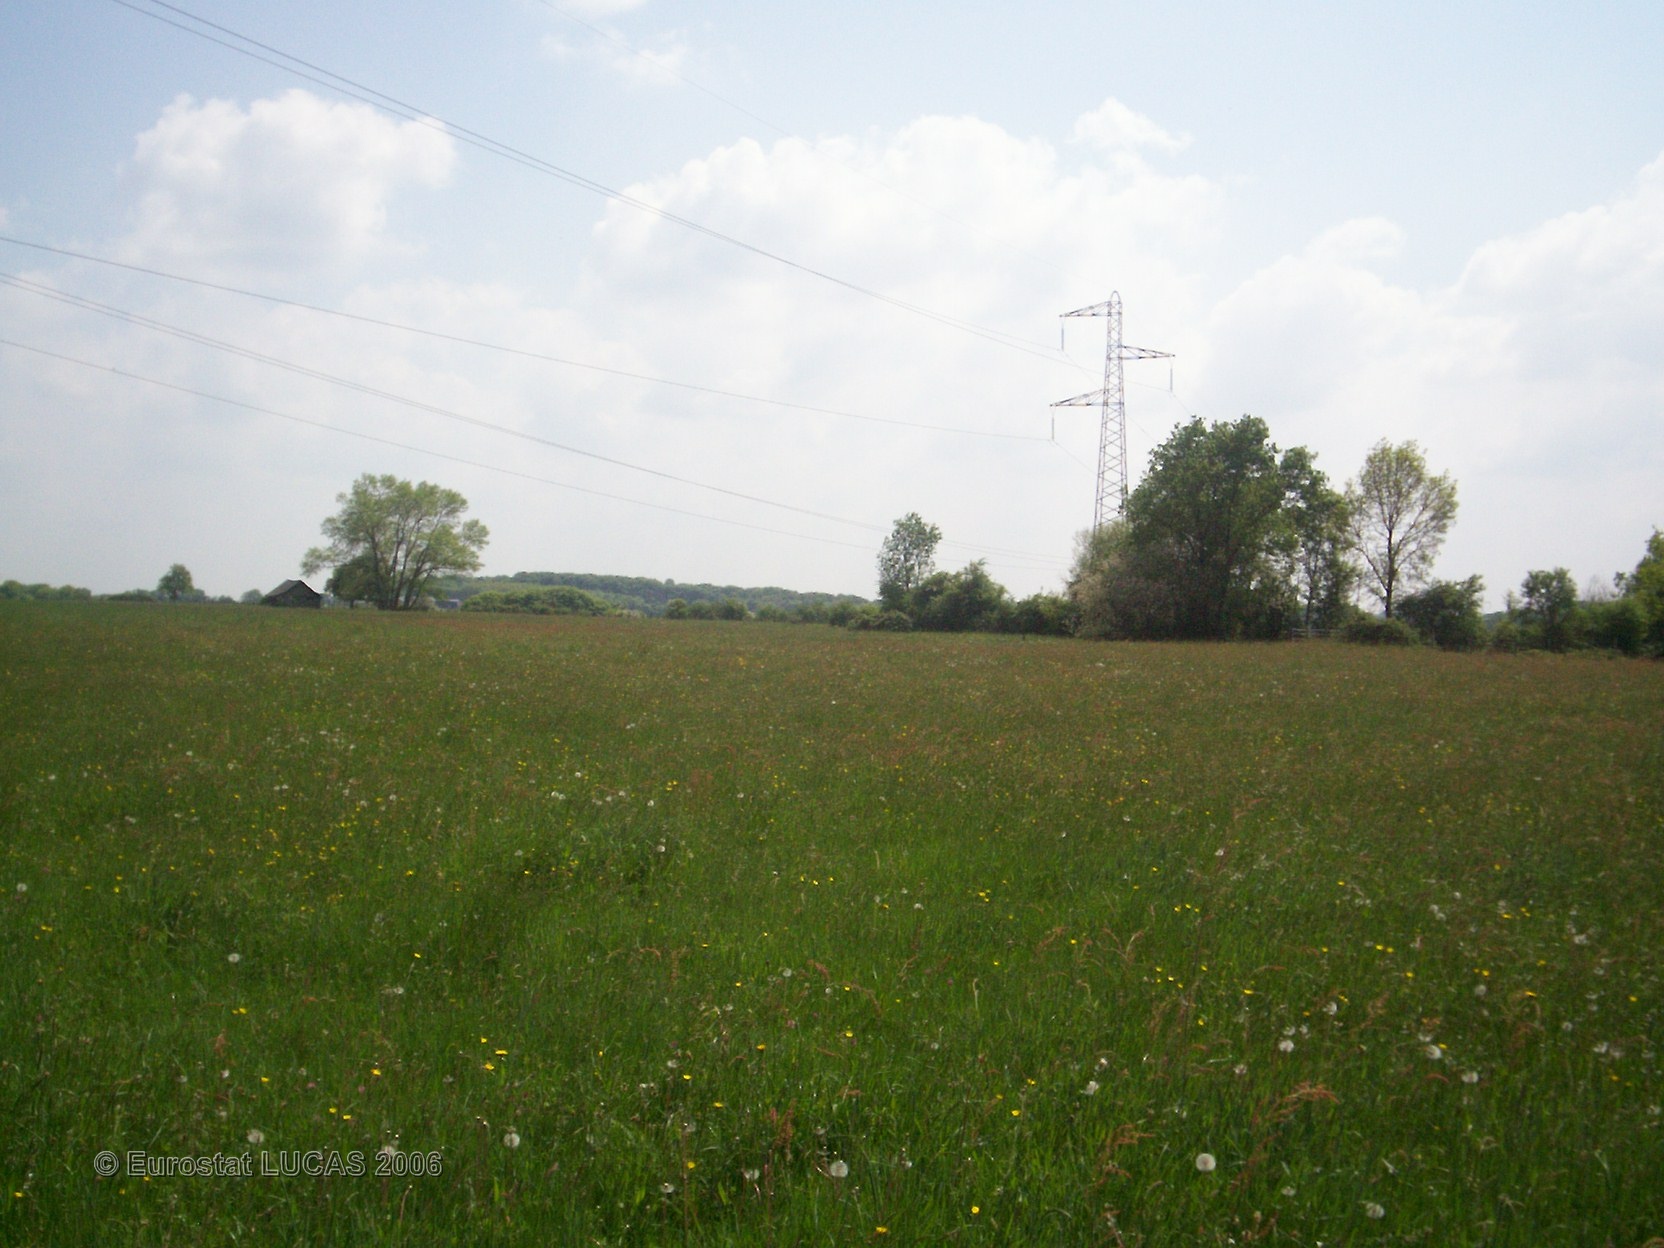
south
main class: Grassland
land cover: Grassland without tree/shrub cover
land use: Agriculture (excluding fallow land and kitchen gardens)
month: May
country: FR
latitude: 47.6960
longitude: 0.2082
